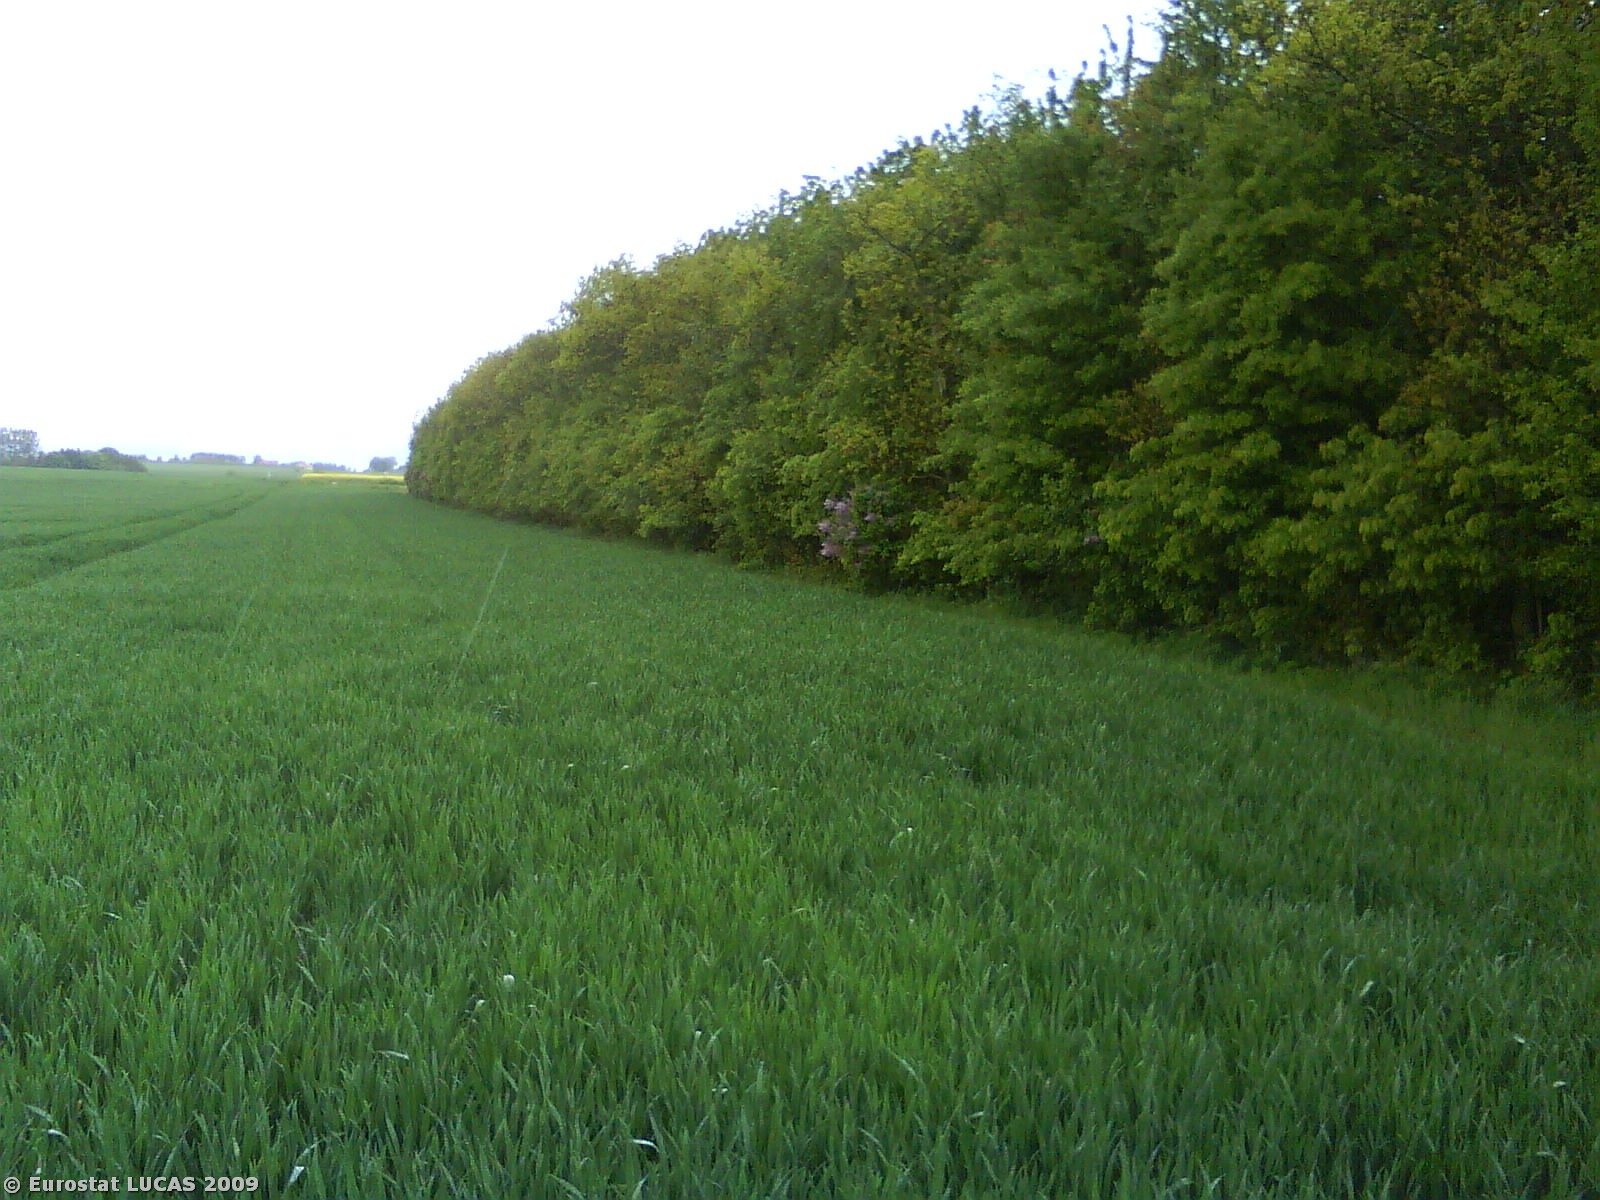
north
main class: Cropland
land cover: Common wheat
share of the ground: > 75 %
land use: Agriculture (excluding fallow land and kitchen gardens)
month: May
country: DK
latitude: 56.3315
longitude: 10.1454
